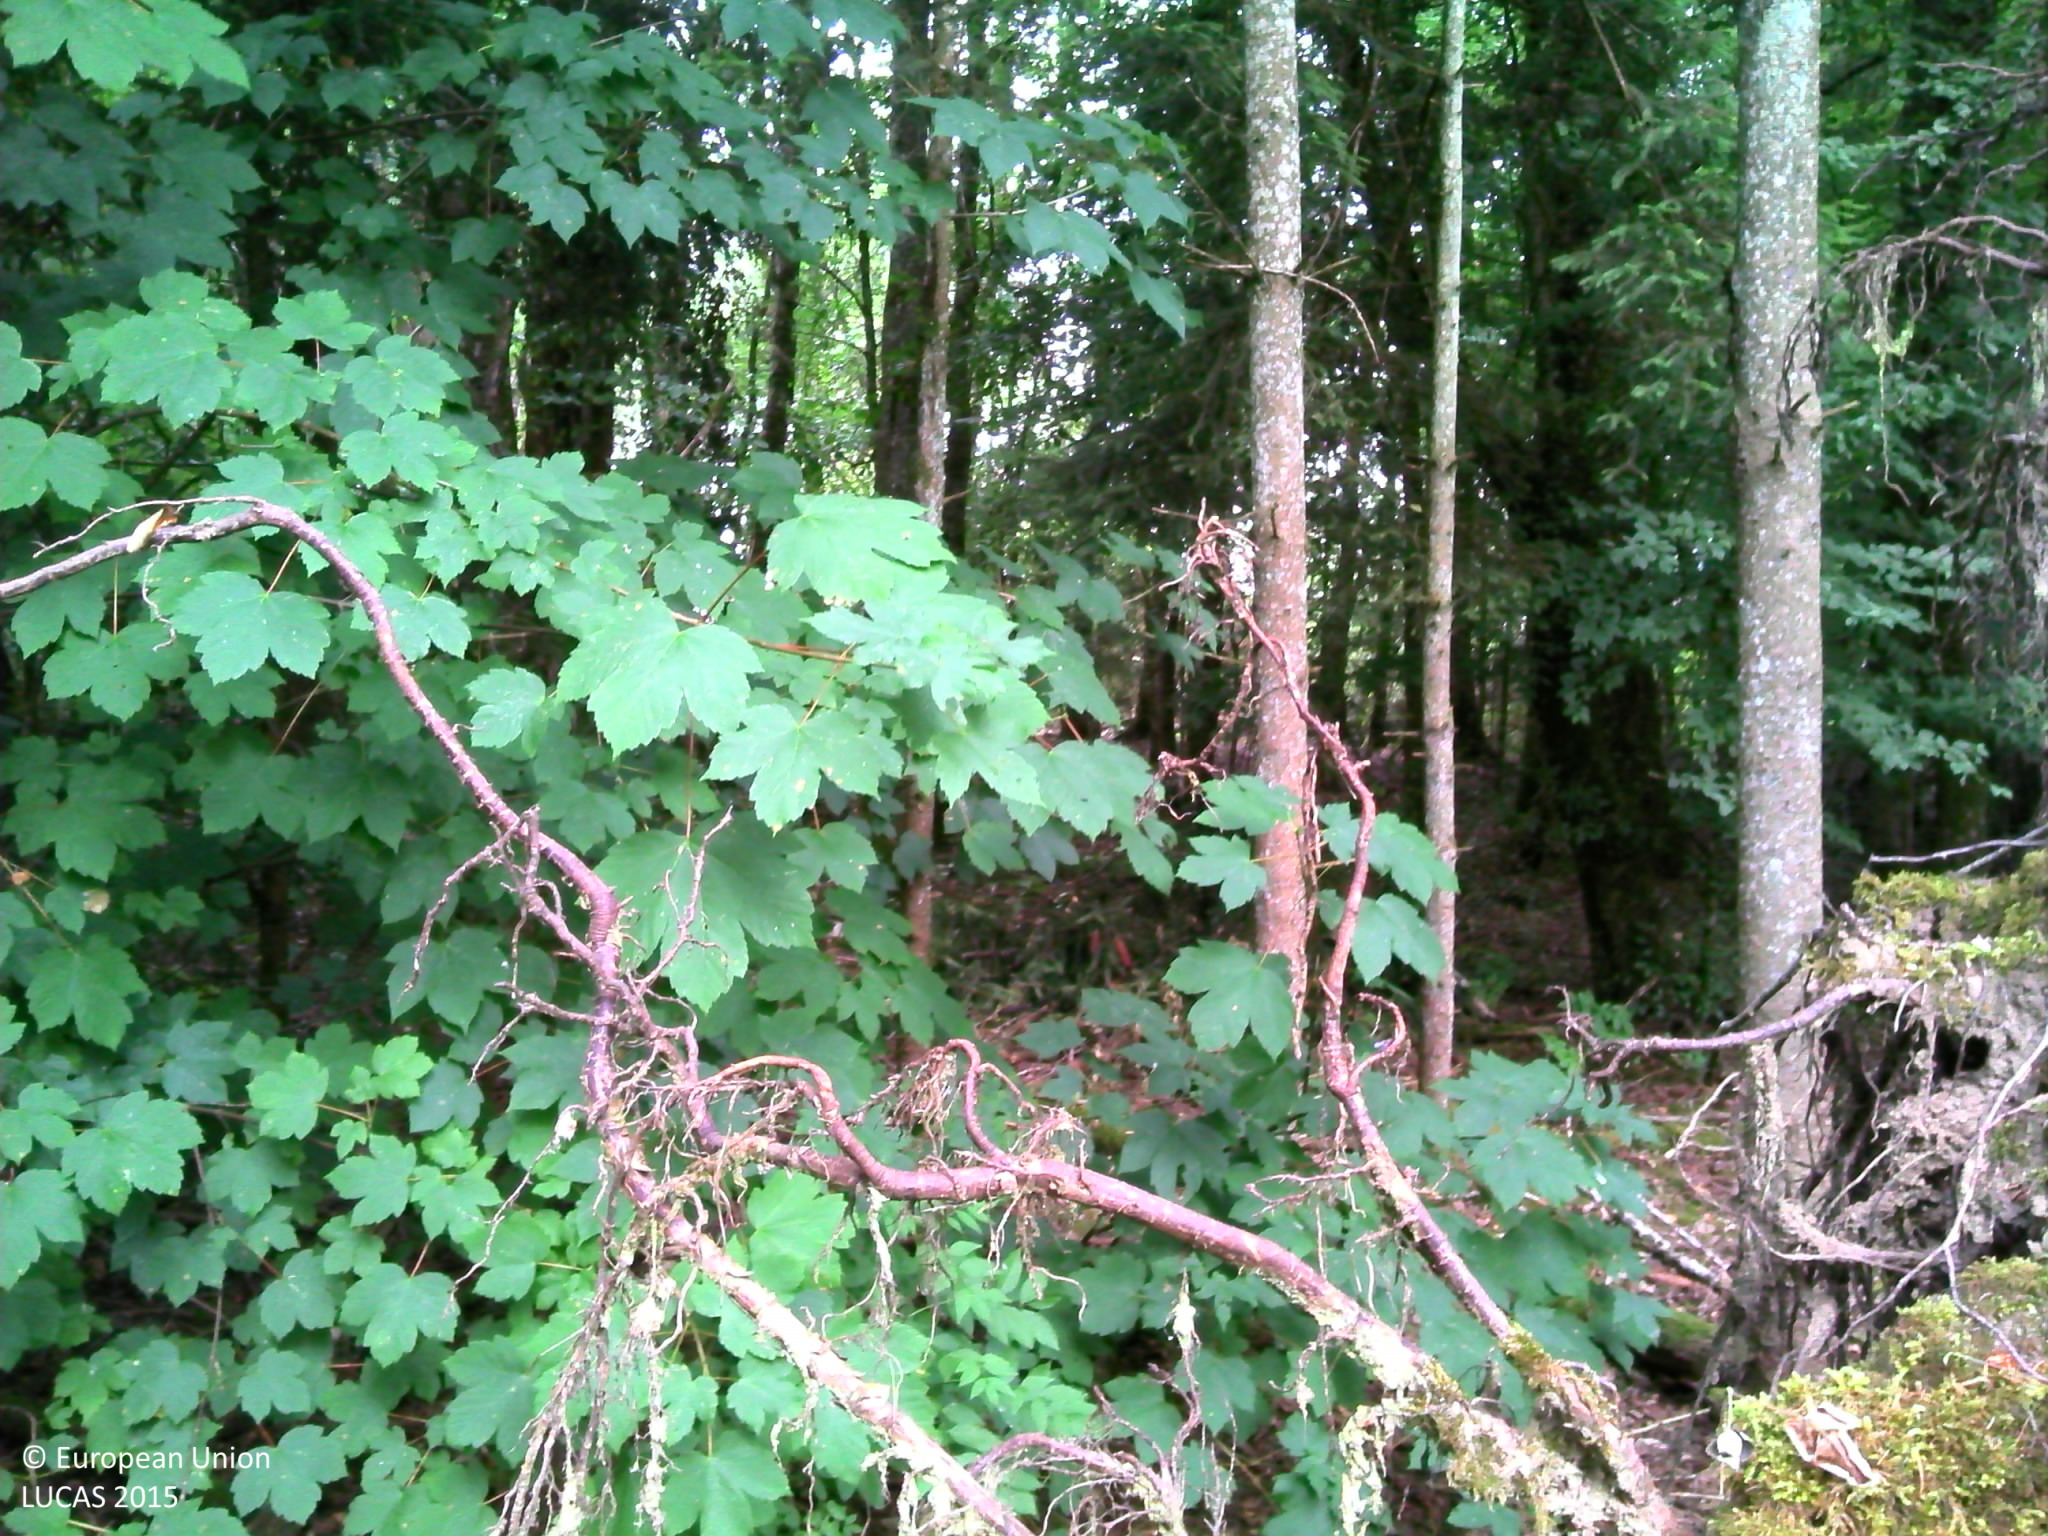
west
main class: Woodland
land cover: Spruce dominated coniferous woodland
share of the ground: 50 - 75 %
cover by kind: coniferous forest trees 60 %, shrubs 25 %, herbaceous plants 10 %, broadleaved forest trees 5 %
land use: Forestry
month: July
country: BE
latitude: 49.6875
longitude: 5.6602
